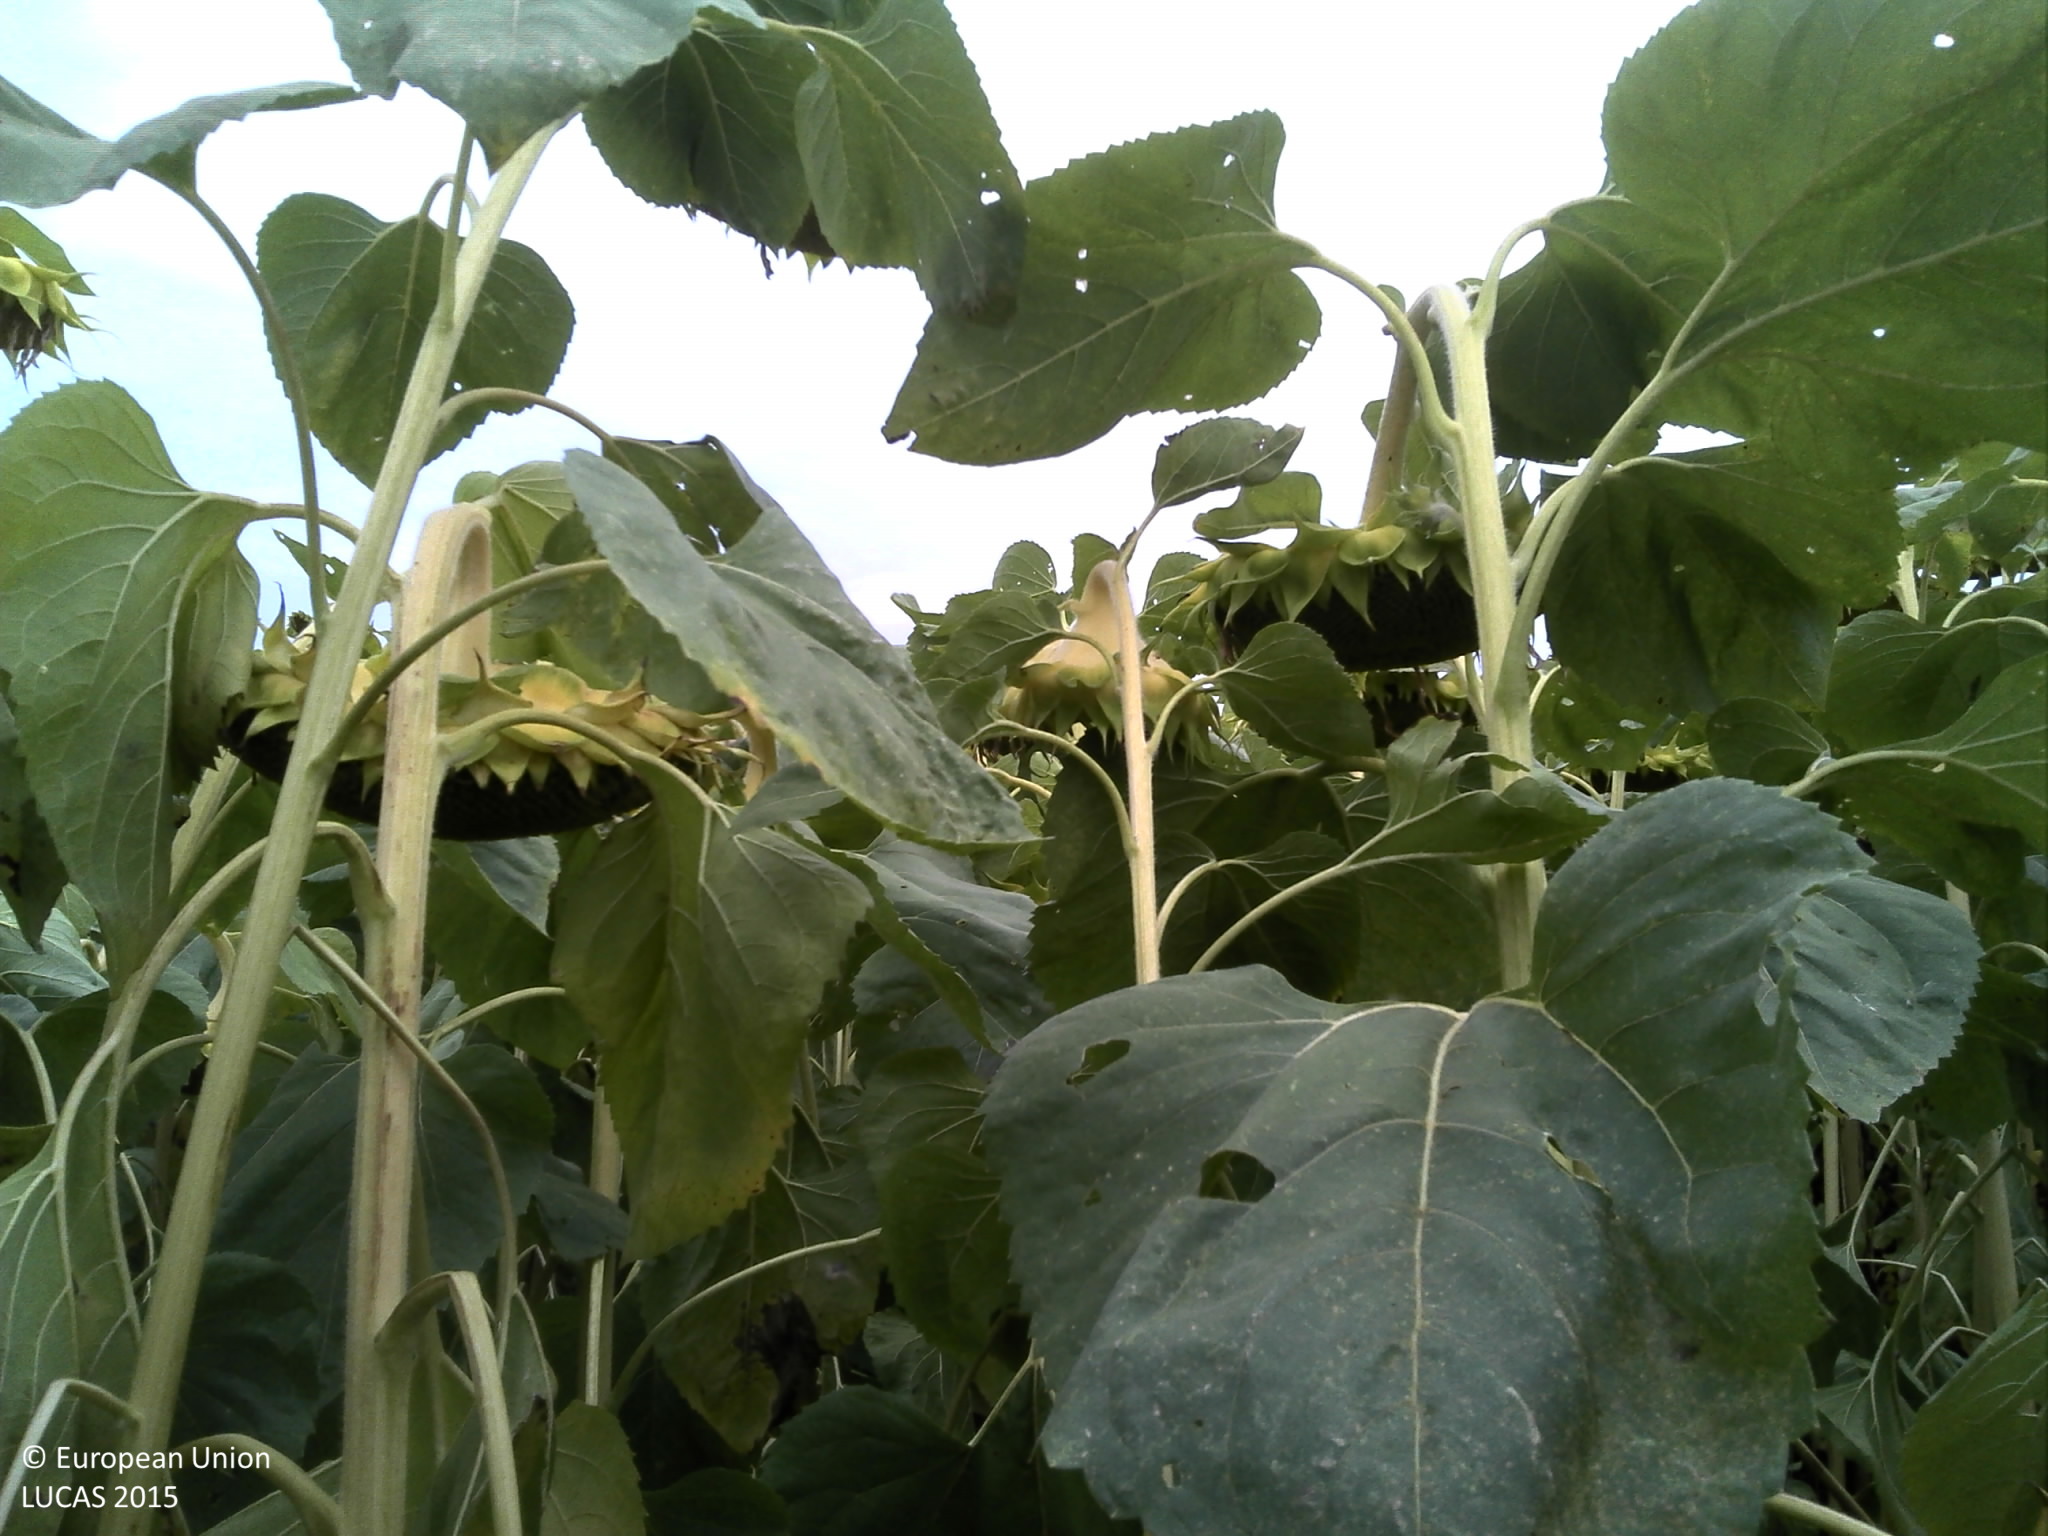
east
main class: Cropland
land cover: Sunflower
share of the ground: > 75 %
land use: Agriculture (excluding fallow land and kitchen gardens)
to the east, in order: Sunflower; Maize
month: July
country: HR
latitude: 45.8574
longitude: 18.6249
